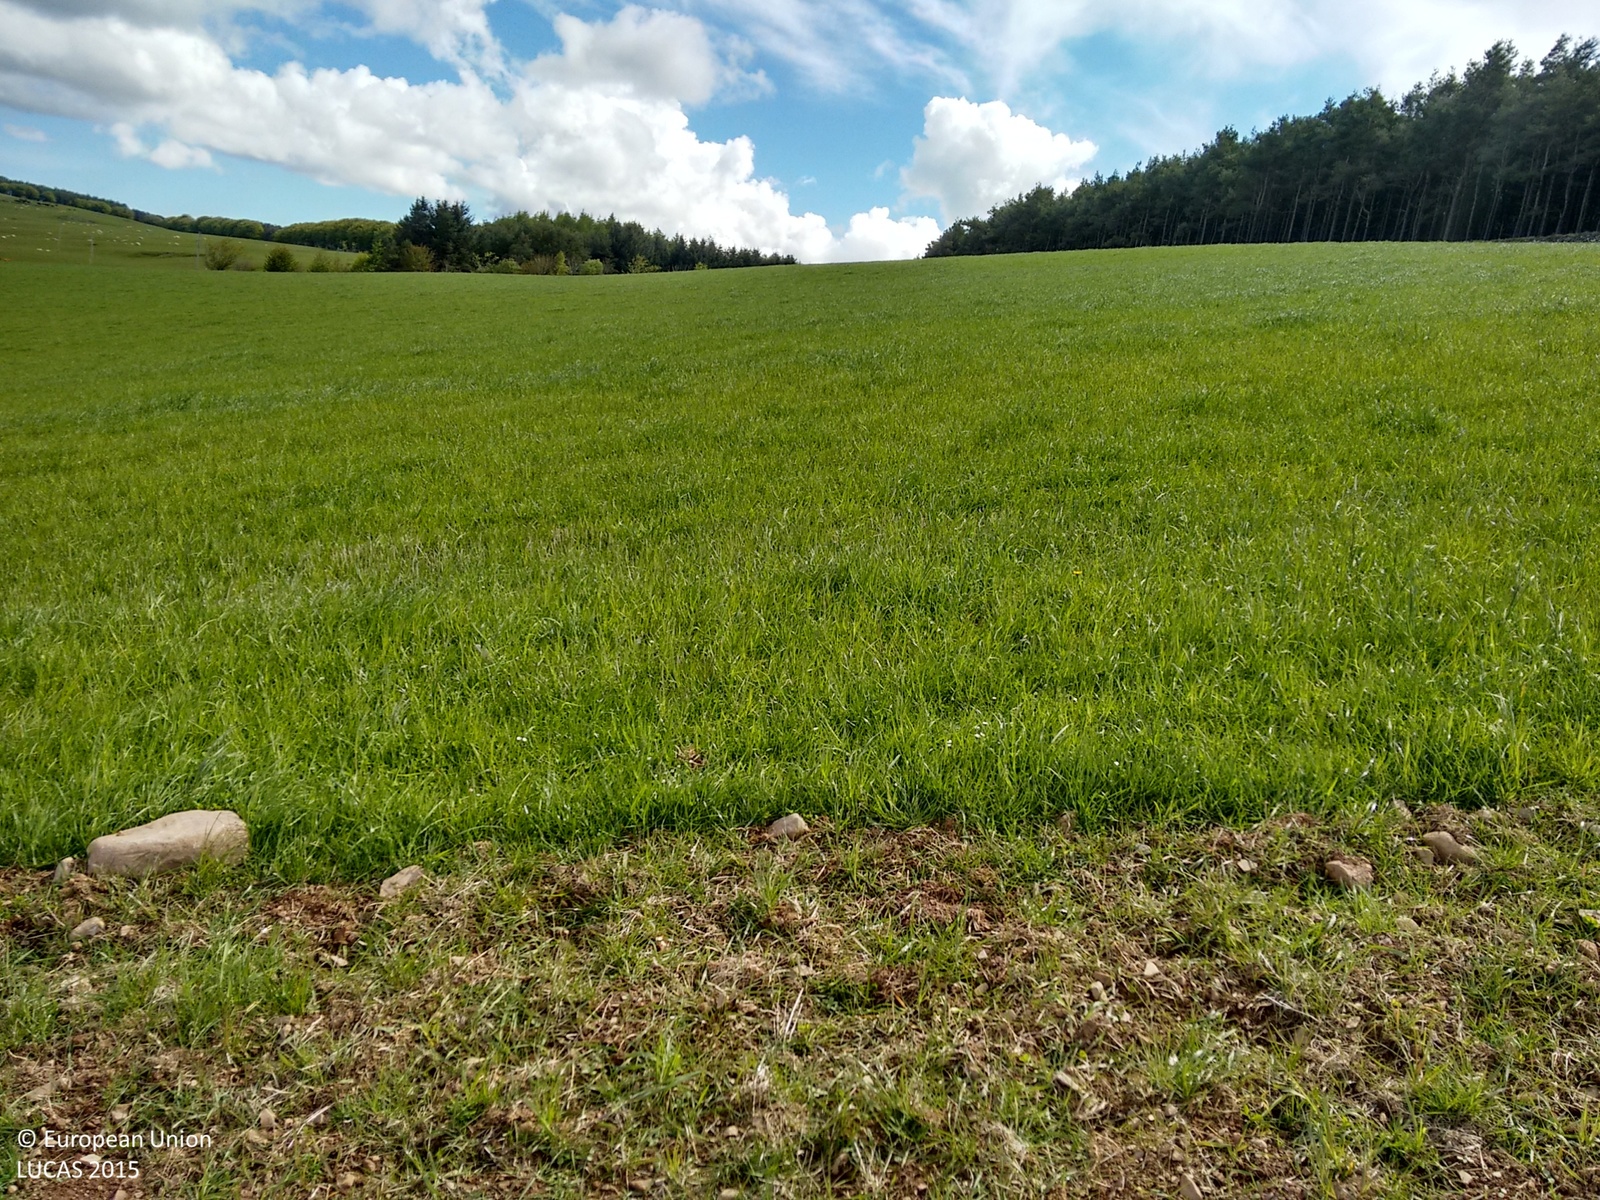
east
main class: Grassland
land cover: Grassland without tree/shrub cover
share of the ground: > 75 %
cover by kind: herbaceous plants 100 %
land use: Agriculture (excluding fallow land and kitchen gardens)
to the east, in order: Grassland without tree/shrub cover; Fences; Grassland without tree/shrub cover; Oats; Grass margins; Fences; Dry stone walls; Pine dominated coniferous woodland
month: May
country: GB
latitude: 55.8268
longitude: -2.3329
